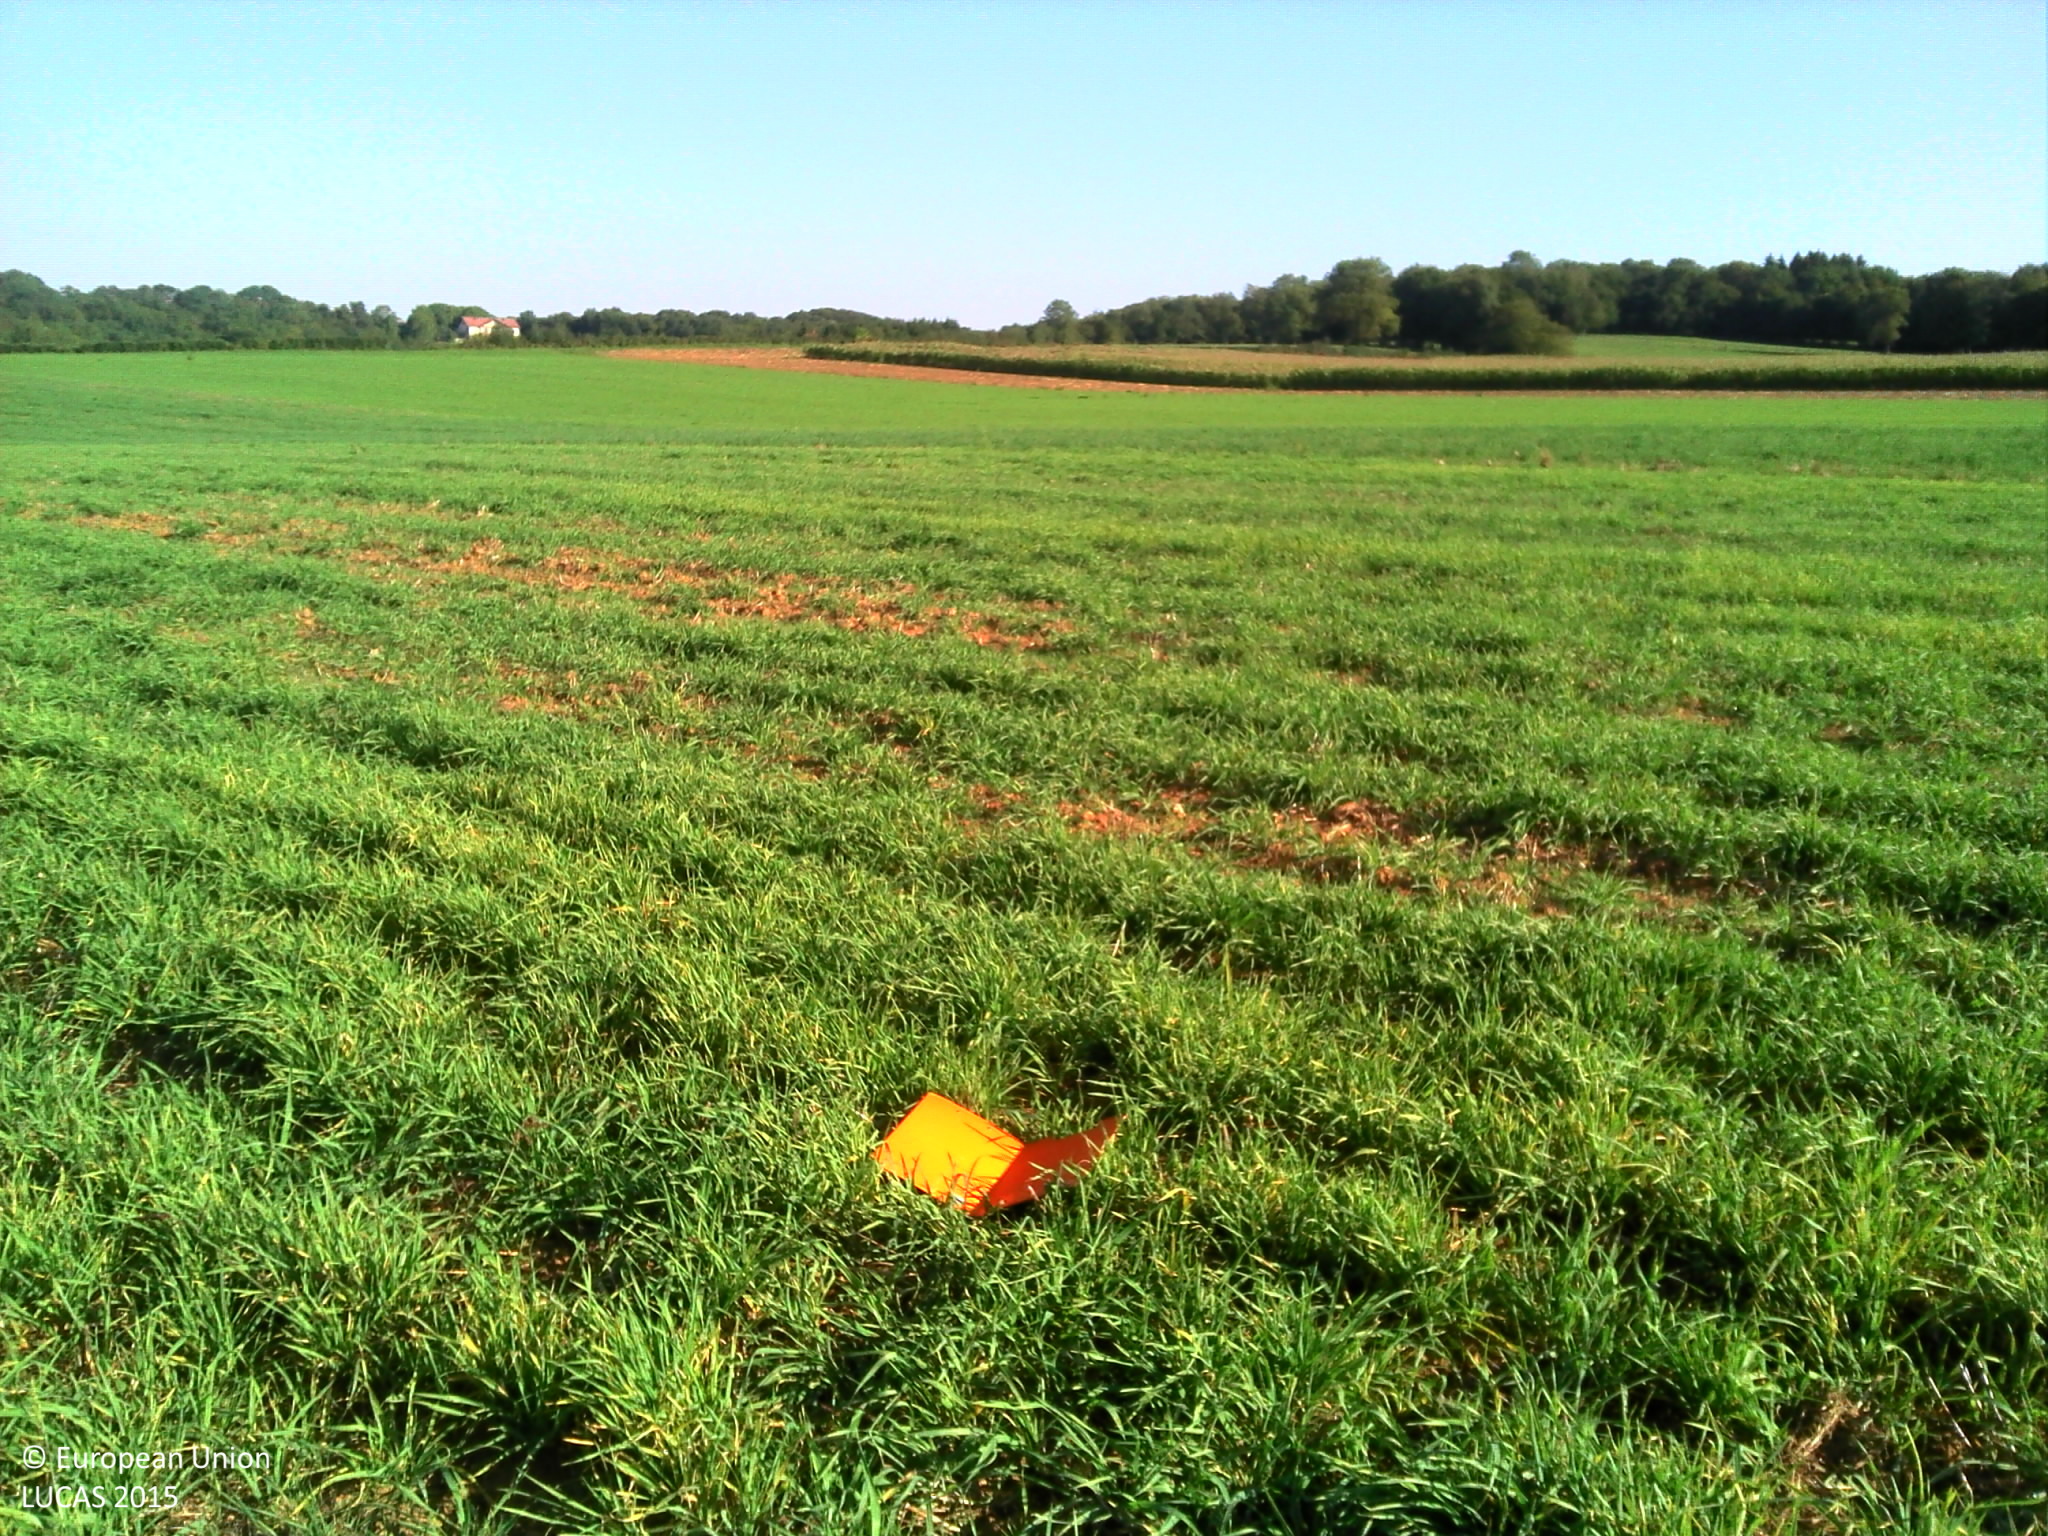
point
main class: Cropland
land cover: Temporary grasslands
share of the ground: > 75 %
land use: Agriculture (excluding fallow land and kitchen gardens)
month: September
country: FR
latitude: 47.2800
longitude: 6.3398
